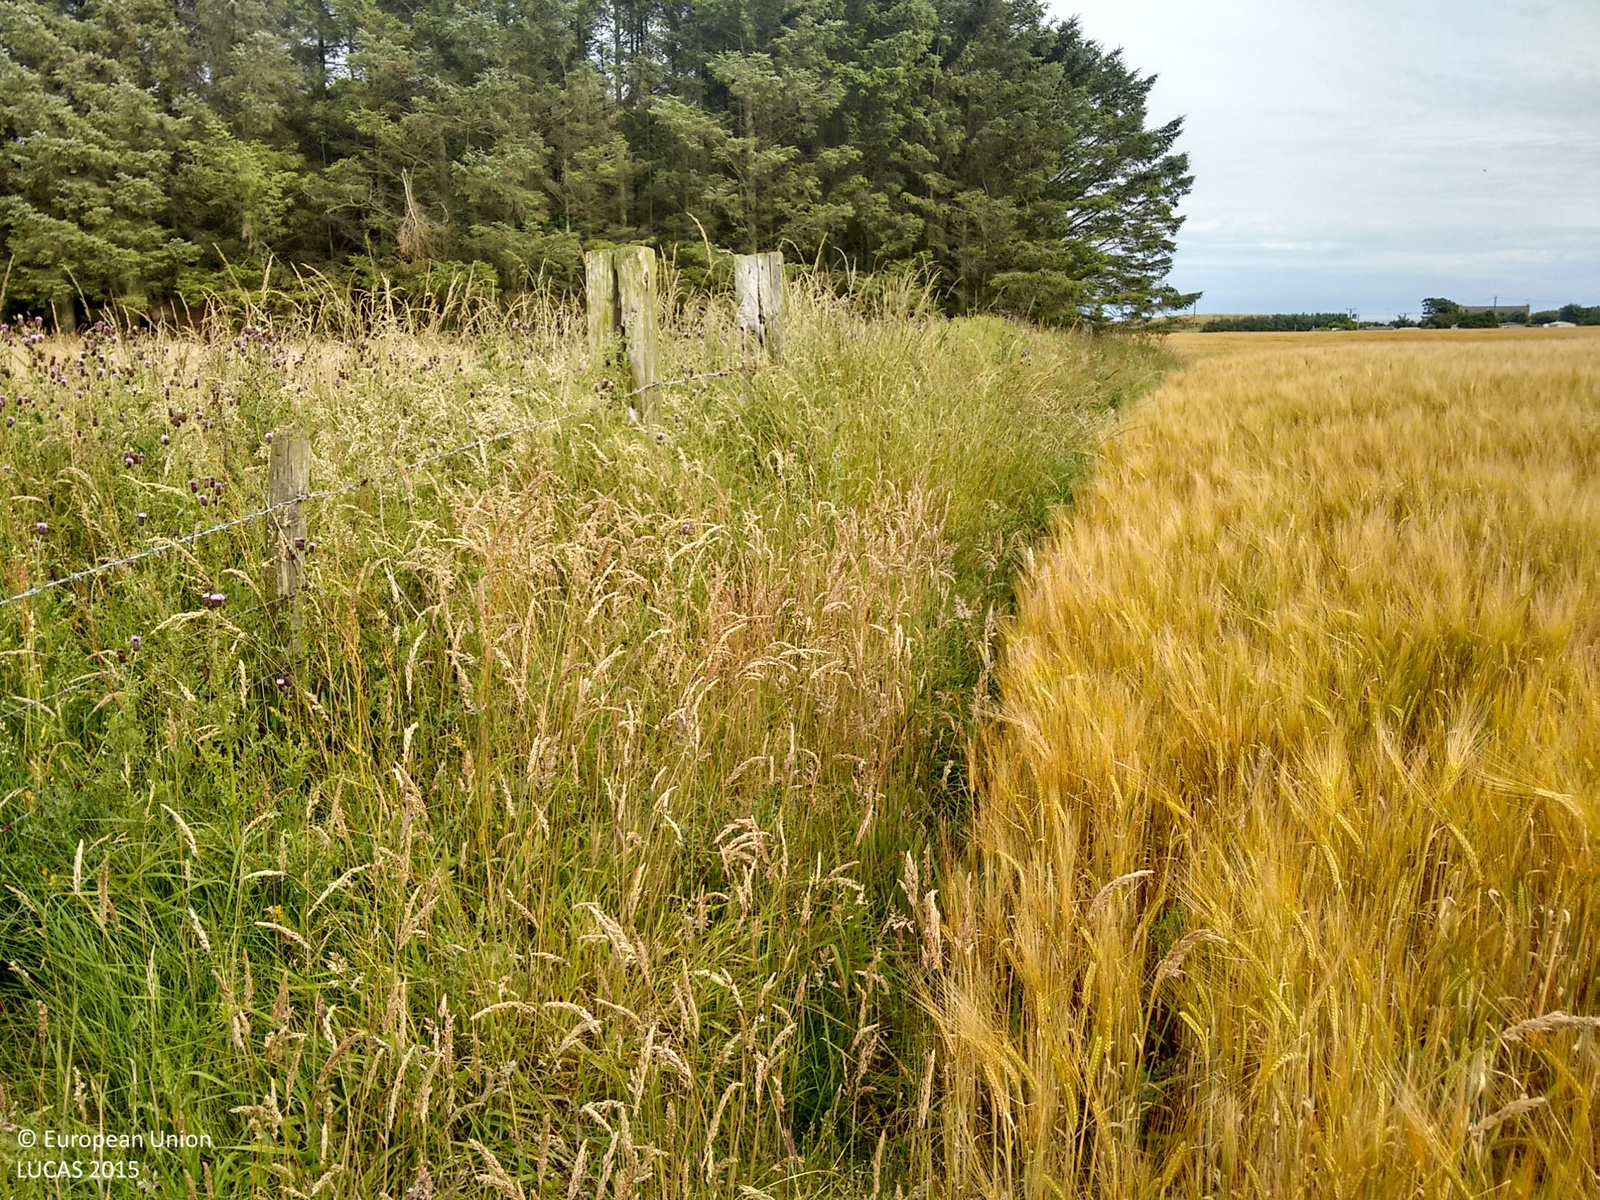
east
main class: Cropland
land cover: Barley
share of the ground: > 75 %
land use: Agriculture (excluding fallow land and kitchen gardens)
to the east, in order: Barley; Grass margins; Fences; Spontaneously vegetated surfaces; Grassland without tree/shrub cover; Spruce dominated coniferous woodland; Artificial constructions in urban areas; Spruce dominated coniferous woodland; Electric lines; Dry stone walls; Grass margins; Tracks; Grassland with sparse tree/shrub cover; Ditches and canals; Grass margins; Tracks; Grass margins; Dry stone walls; Fences; Abandoned hedges; Barley
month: August
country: GB
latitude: 57.2163
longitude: -2.0860
